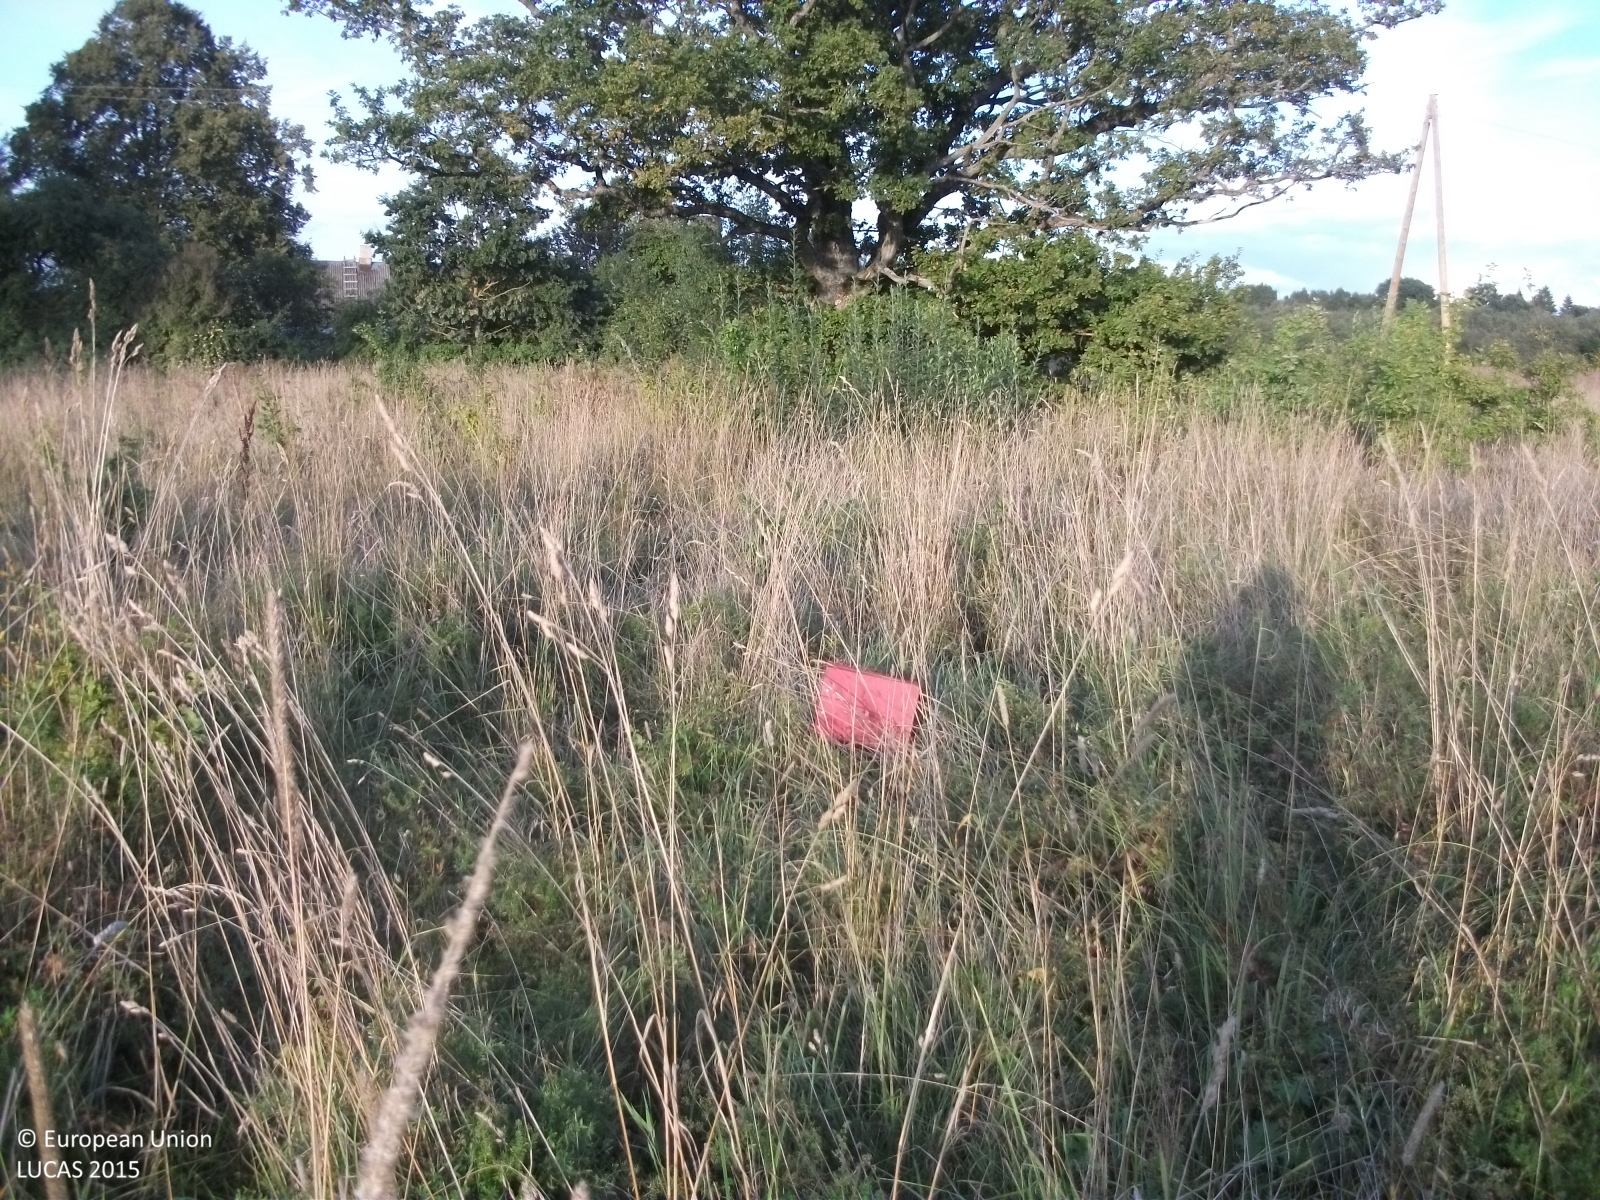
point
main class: Grassland
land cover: Grassland with sparse tree/shrub cover
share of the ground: > 75 %
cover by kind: herbaceous plants 90 %, broadleaved forest trees 5 %, shrubs 5 %
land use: Abandoned areas
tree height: < 5 m
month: September
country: LV
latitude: 57.5714
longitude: 24.5204
